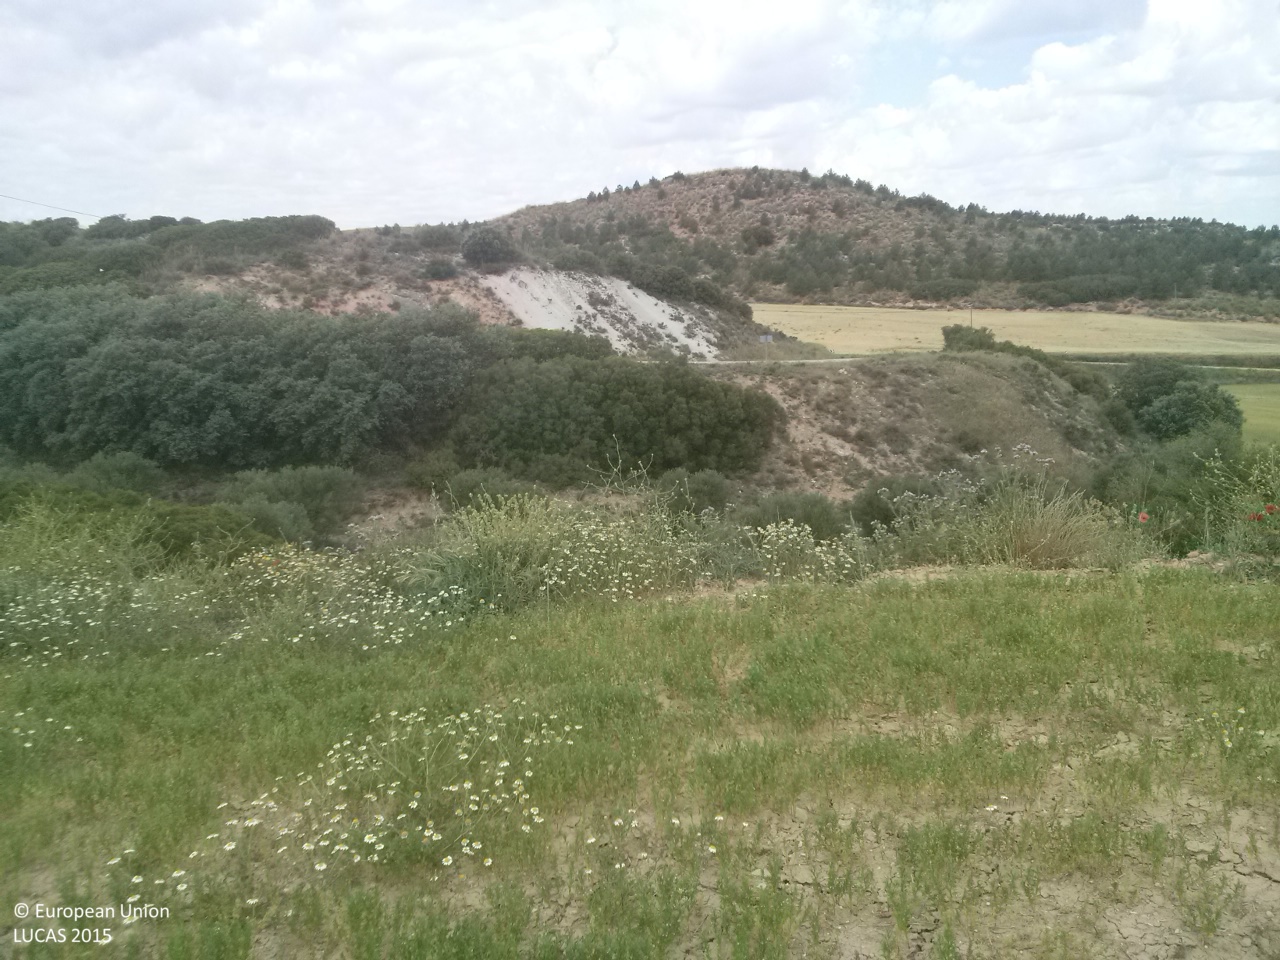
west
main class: Cropland
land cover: Dry pulses
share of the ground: > 75 %
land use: Agriculture (excluding fallow land and kitchen gardens)
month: May
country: ES
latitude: 40.1079
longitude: -2.8935
